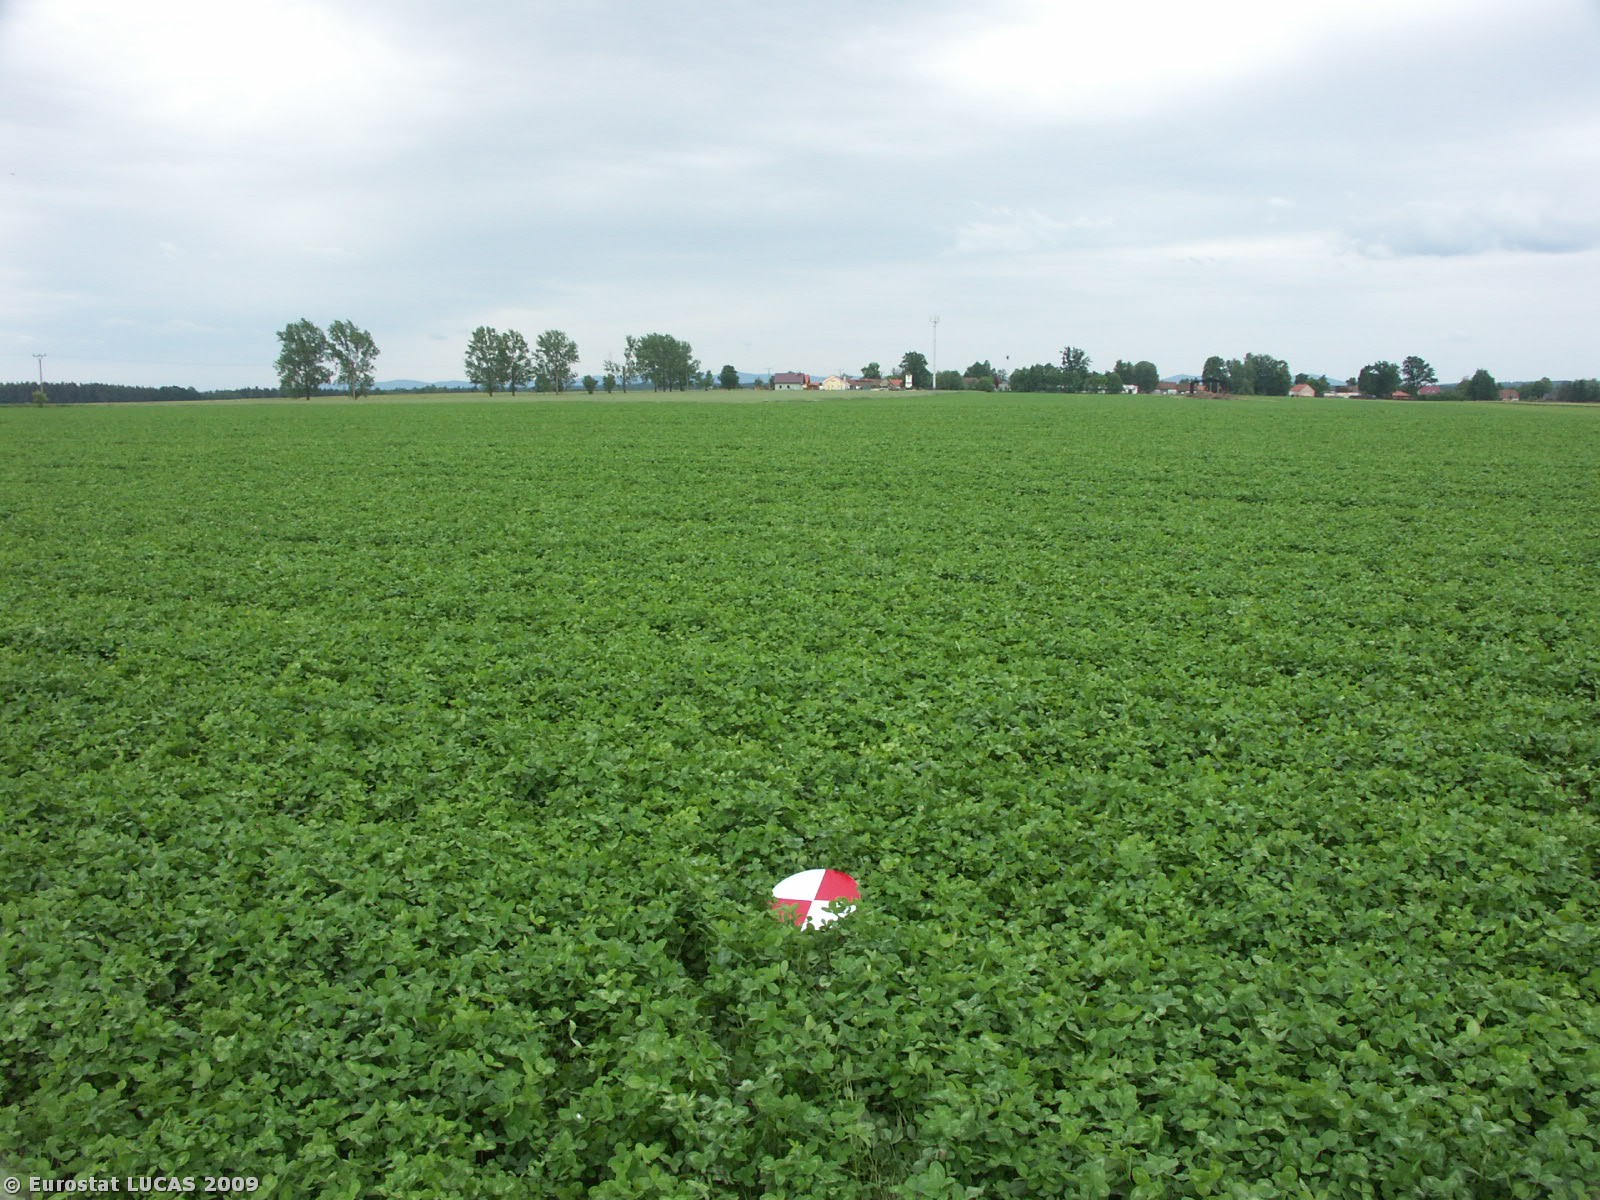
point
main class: Cropland
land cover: Clovers
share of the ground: > 75 %
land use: Agriculture (excluding fallow land and kitchen gardens)
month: June
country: CZ
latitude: 48.9721
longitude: 14.6599
